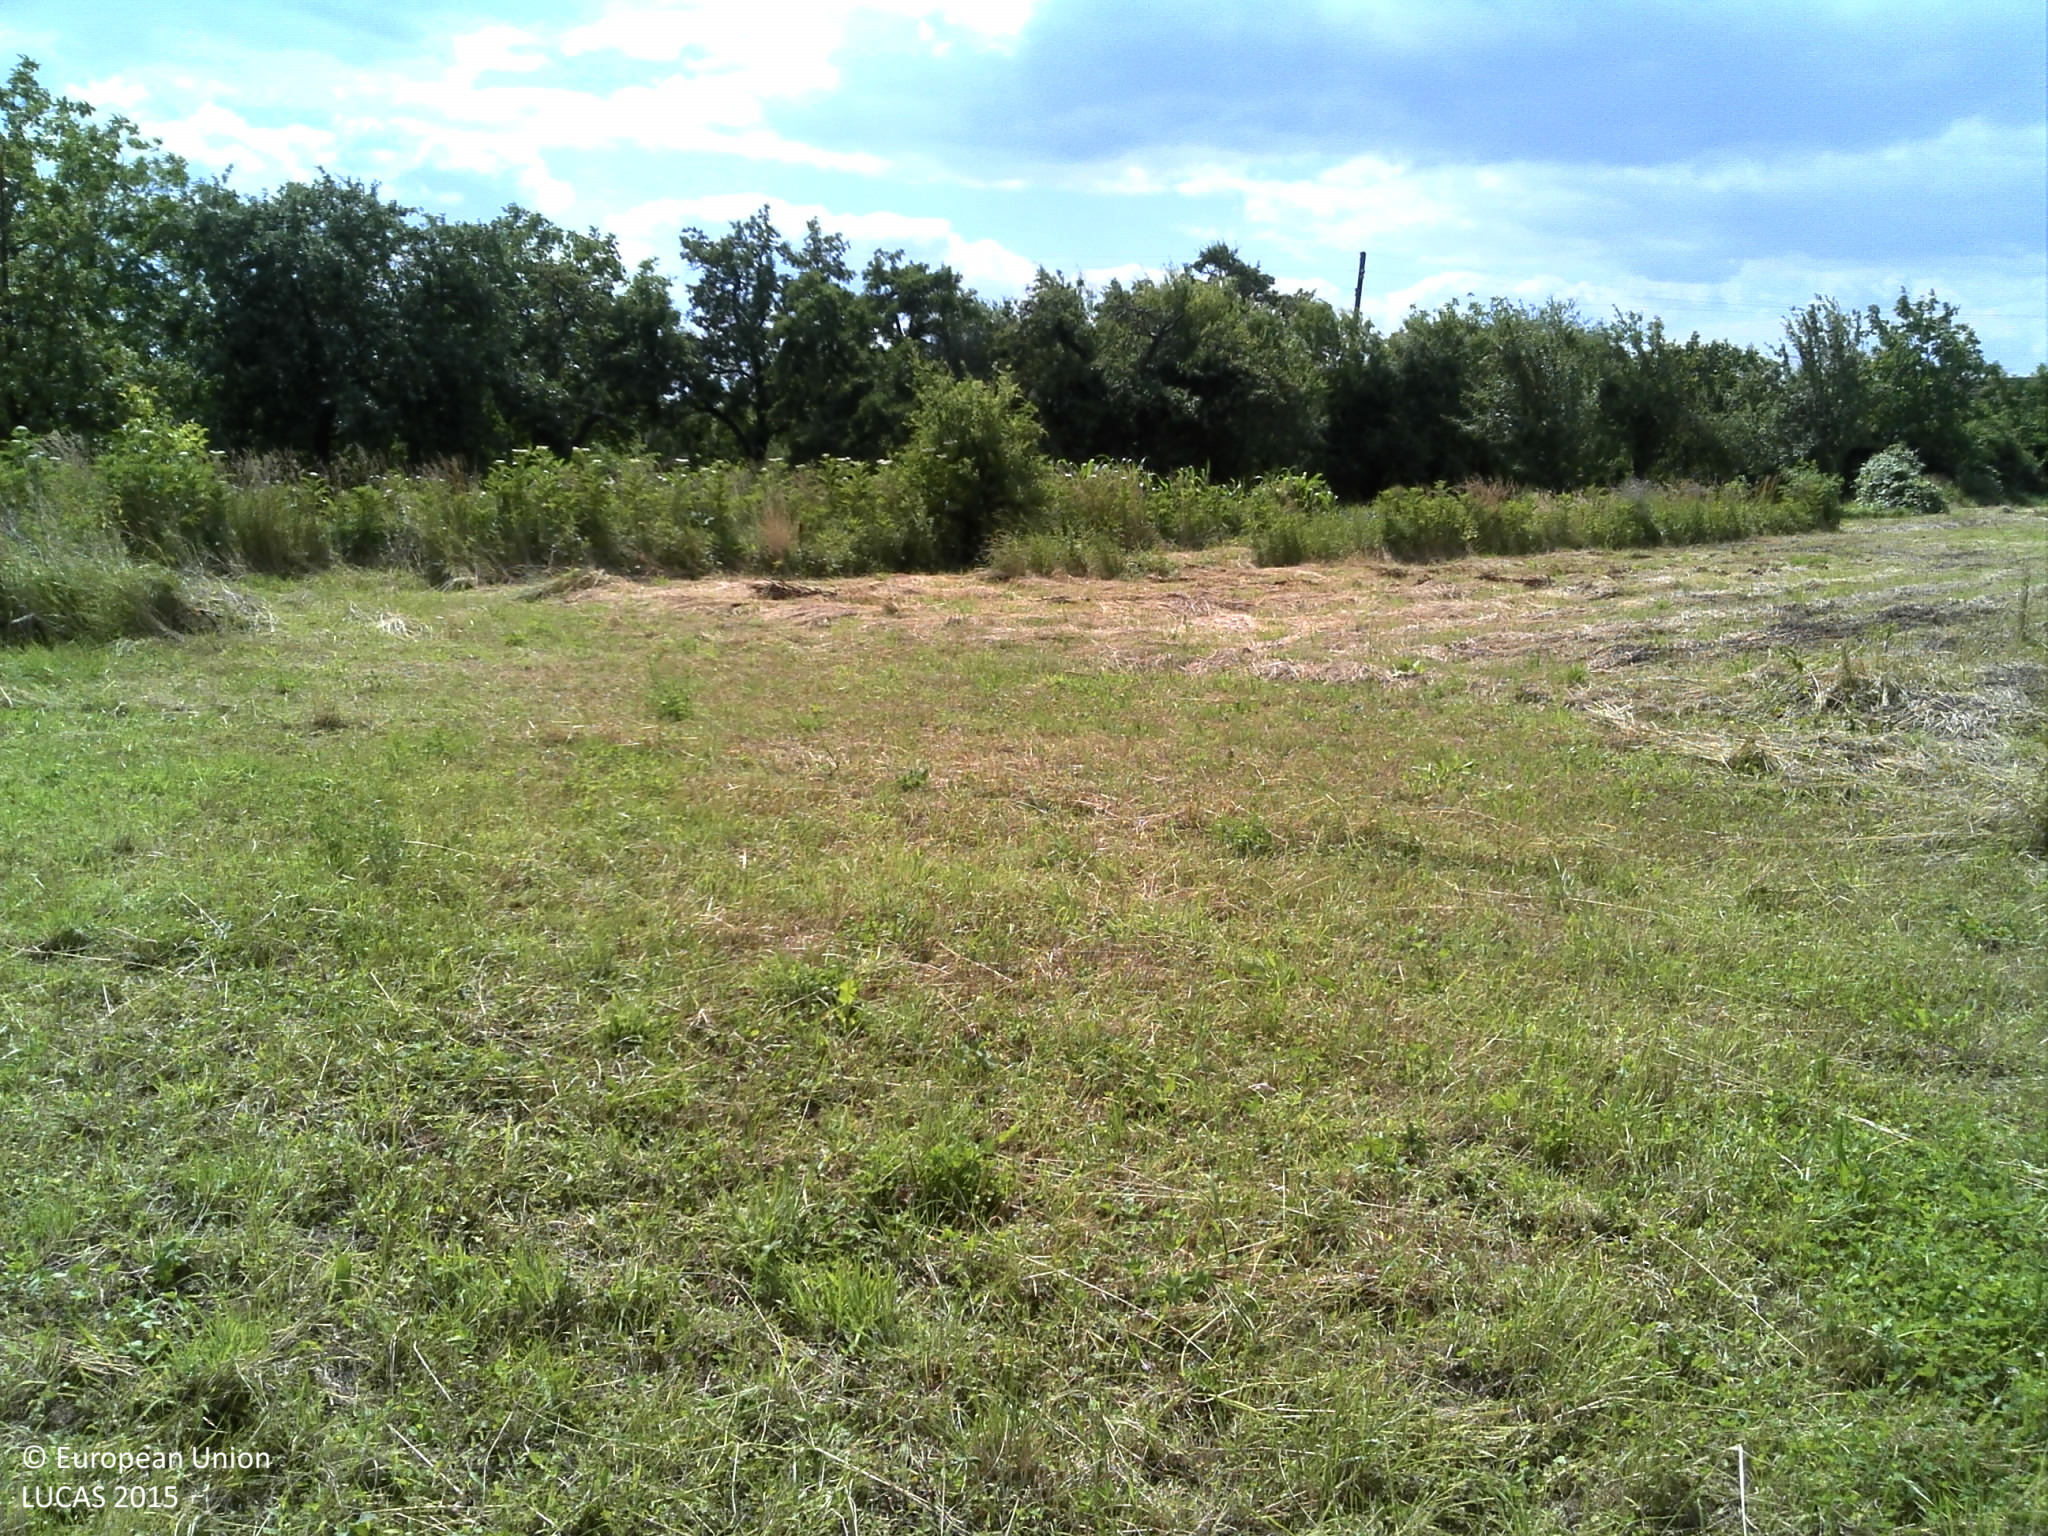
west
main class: Grassland
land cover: Grassland without tree/shrub cover
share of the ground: > 75 %
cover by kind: herbaceous plants 100 %
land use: Agriculture (excluding fallow land and kitchen gardens)
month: June
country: HR
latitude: 45.2585
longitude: 17.1994
